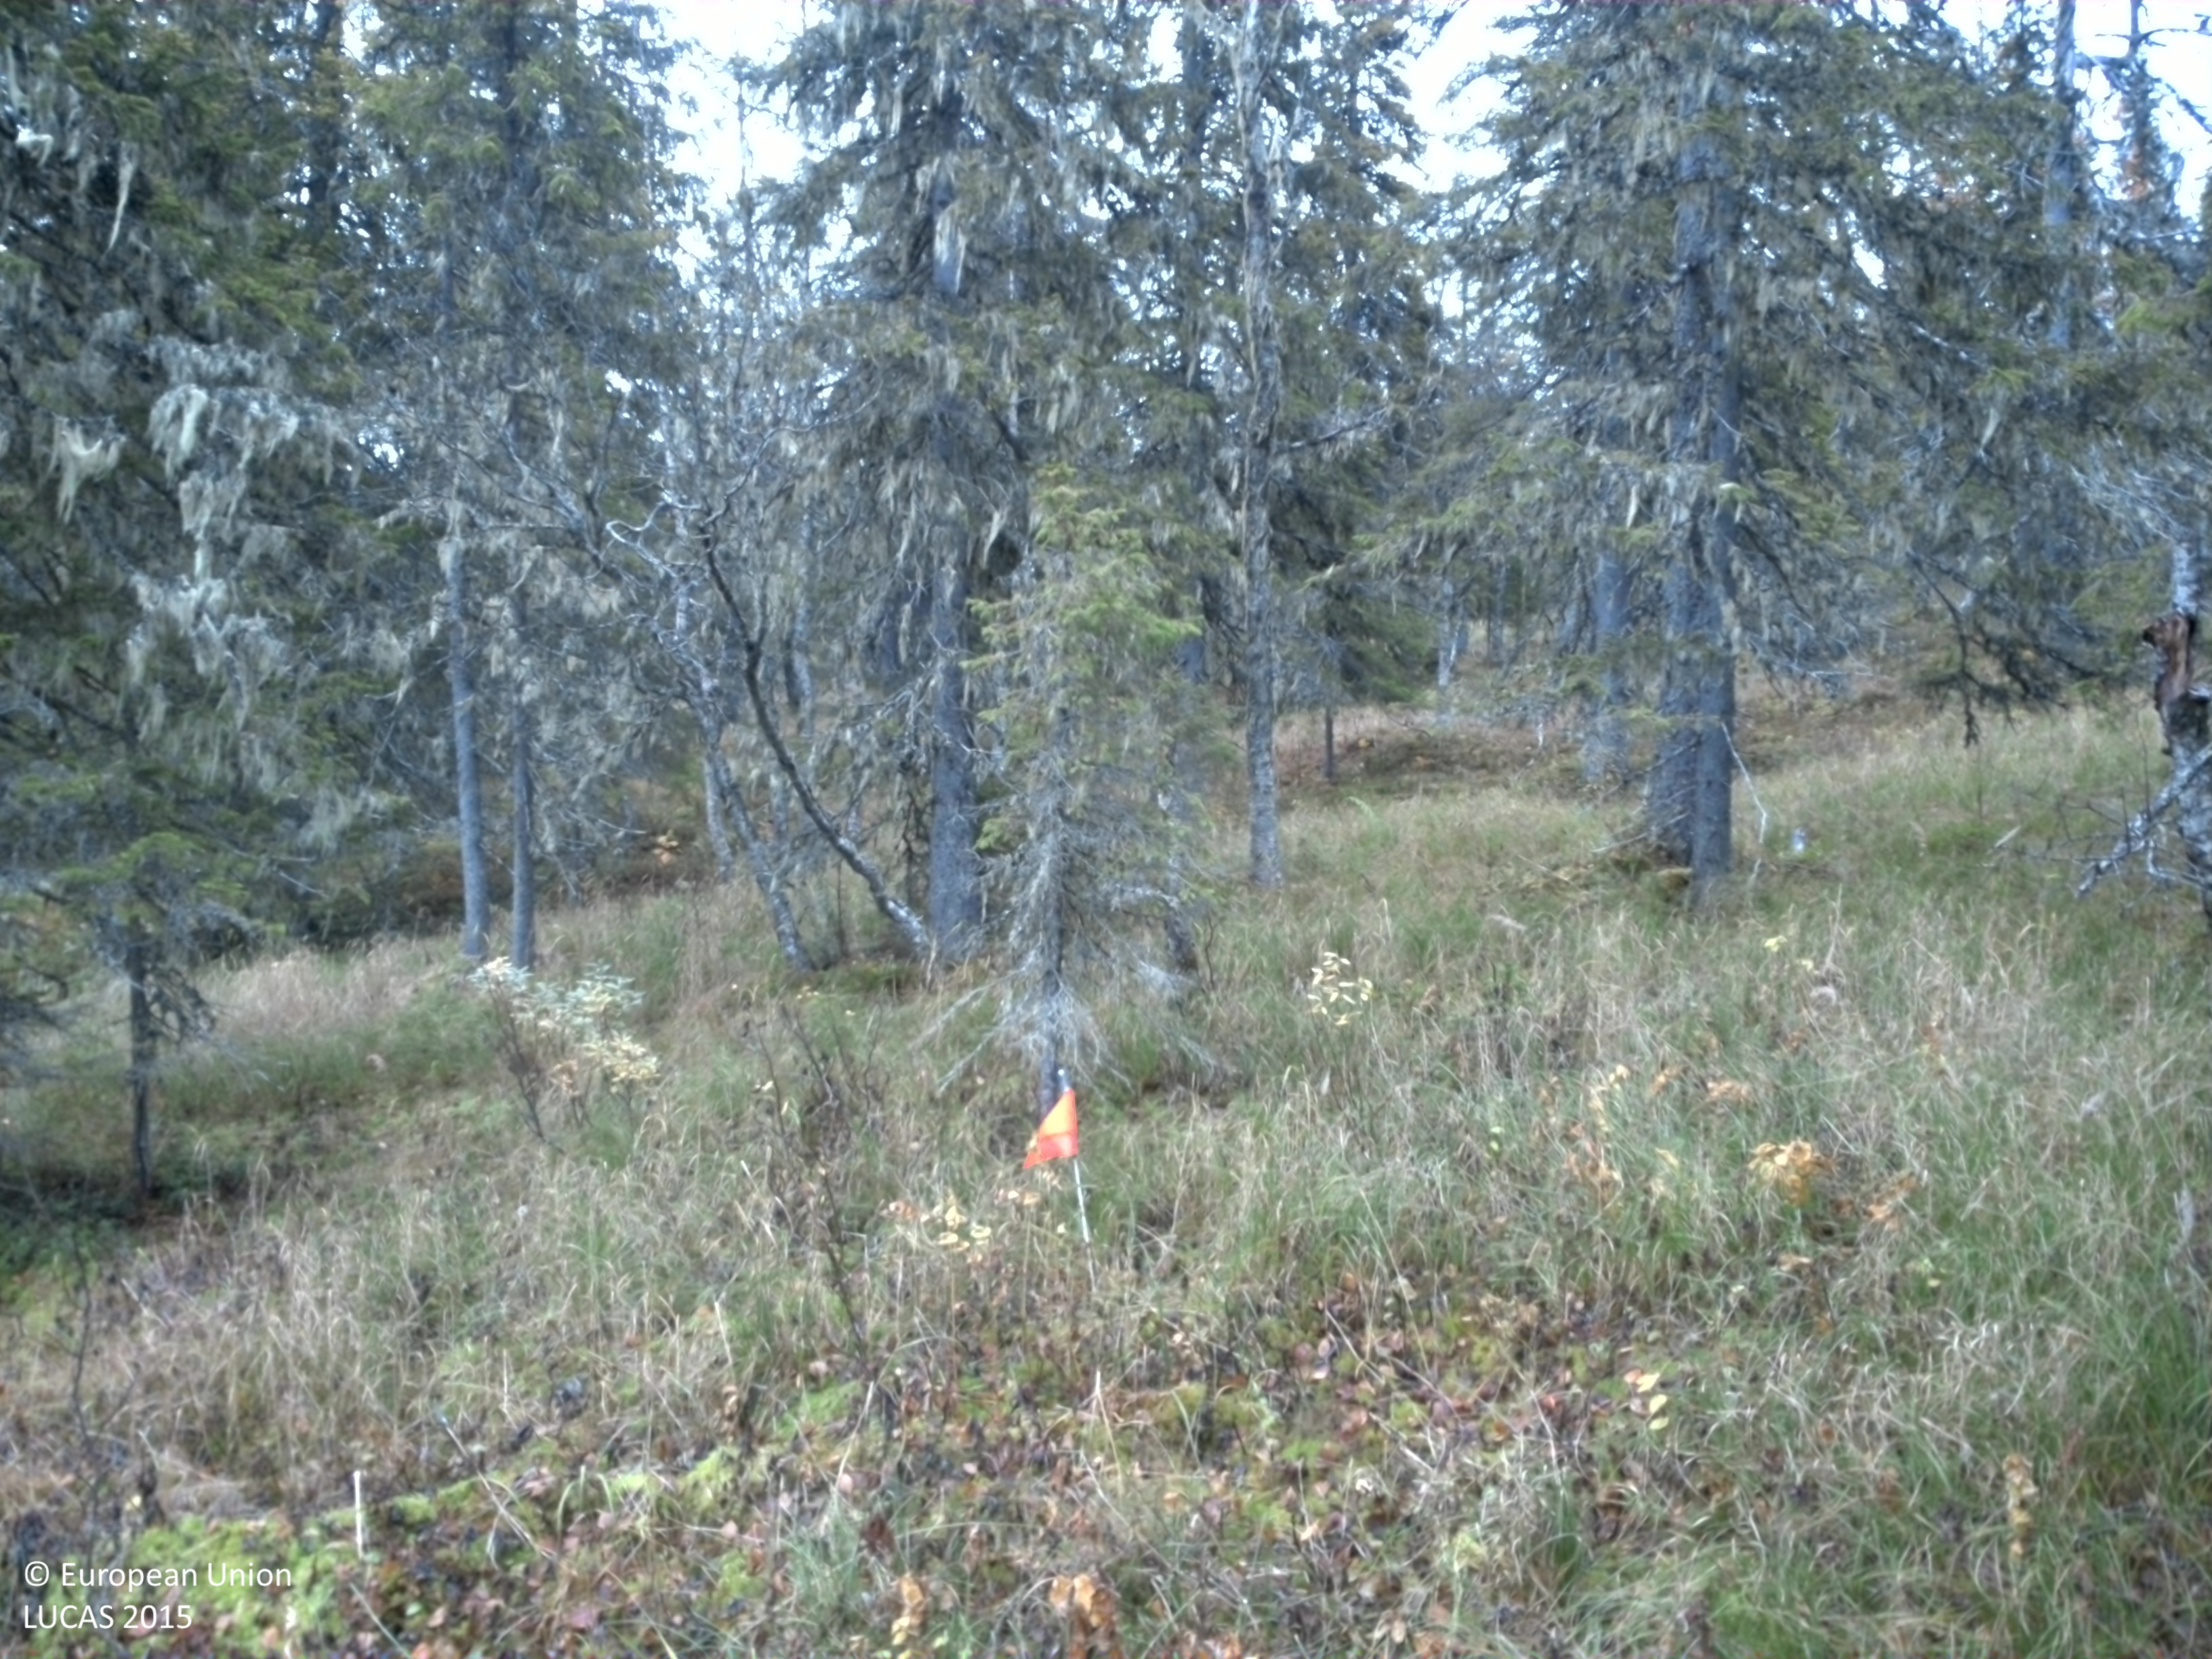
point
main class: Woodland
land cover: Spruce dominated coniferous woodland
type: boreal forest
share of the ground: 25 - 50 %
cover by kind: herbaceous plants 40 %, coniferous forest trees 20 %, lichens and mosses 20 %, shrubs 15 %, broadleaved forest trees 5 %
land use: Semi-natural and natural areas not in use
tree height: > 5 m
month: October
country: SE
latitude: 64.9596
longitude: 16.8039
